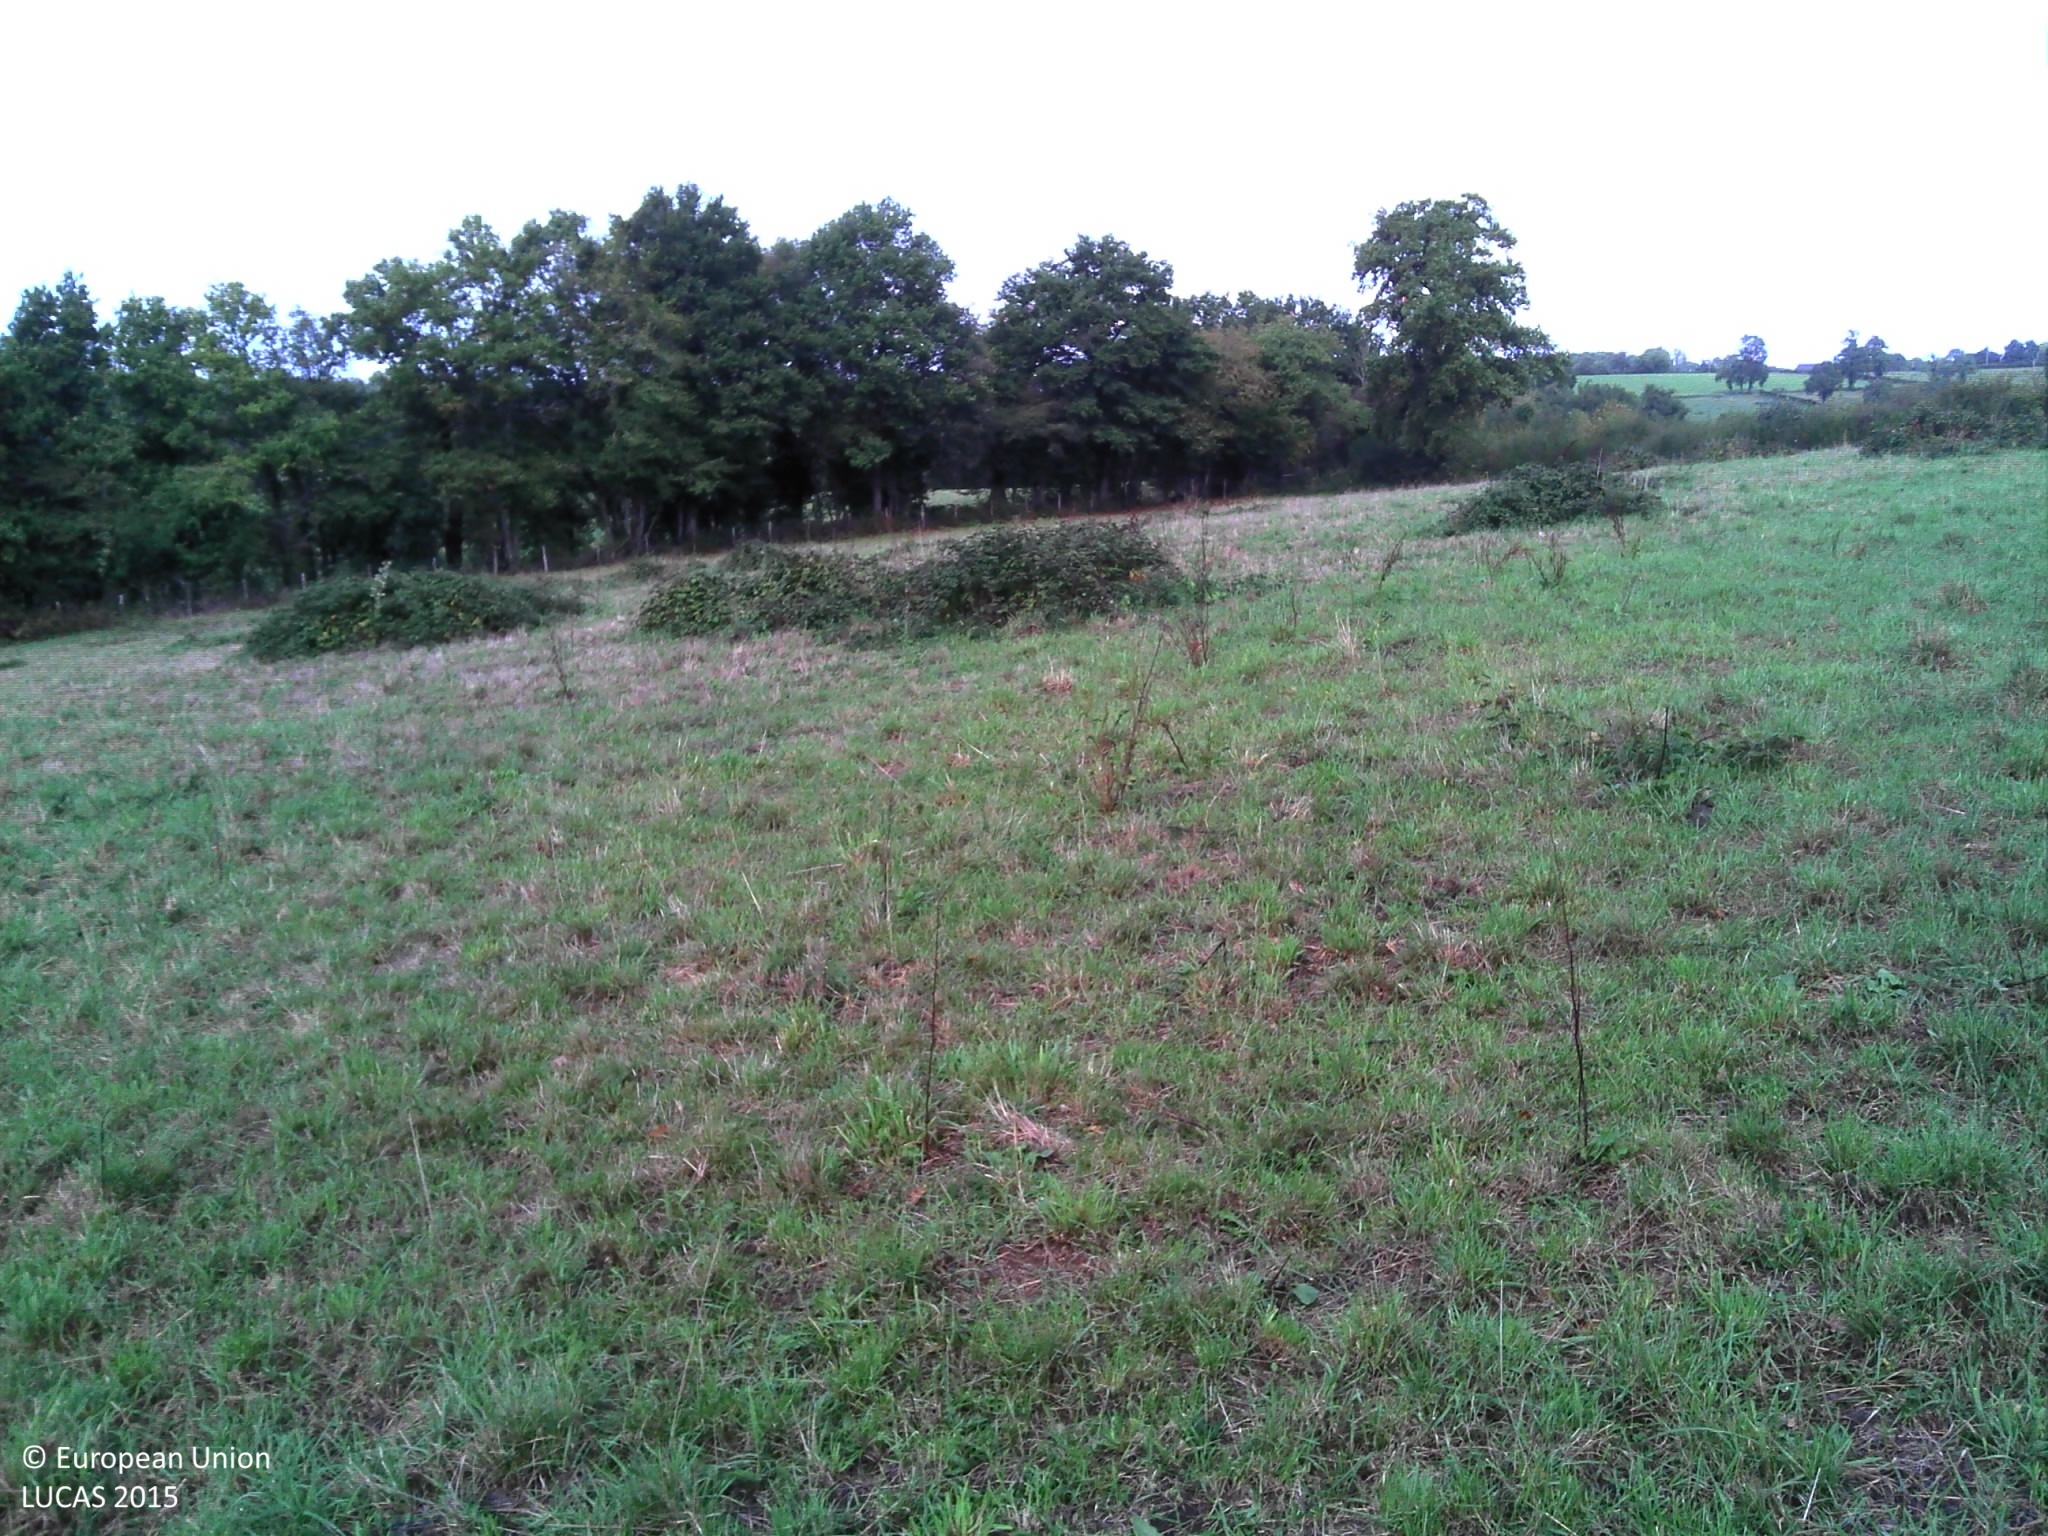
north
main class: Grassland
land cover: Grassland without tree/shrub cover
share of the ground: > 75 %
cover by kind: herbaceous plants 100 %
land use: Agriculture (excluding fallow land and kitchen gardens)
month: September
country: FR
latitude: 46.4445
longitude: 1.6993
